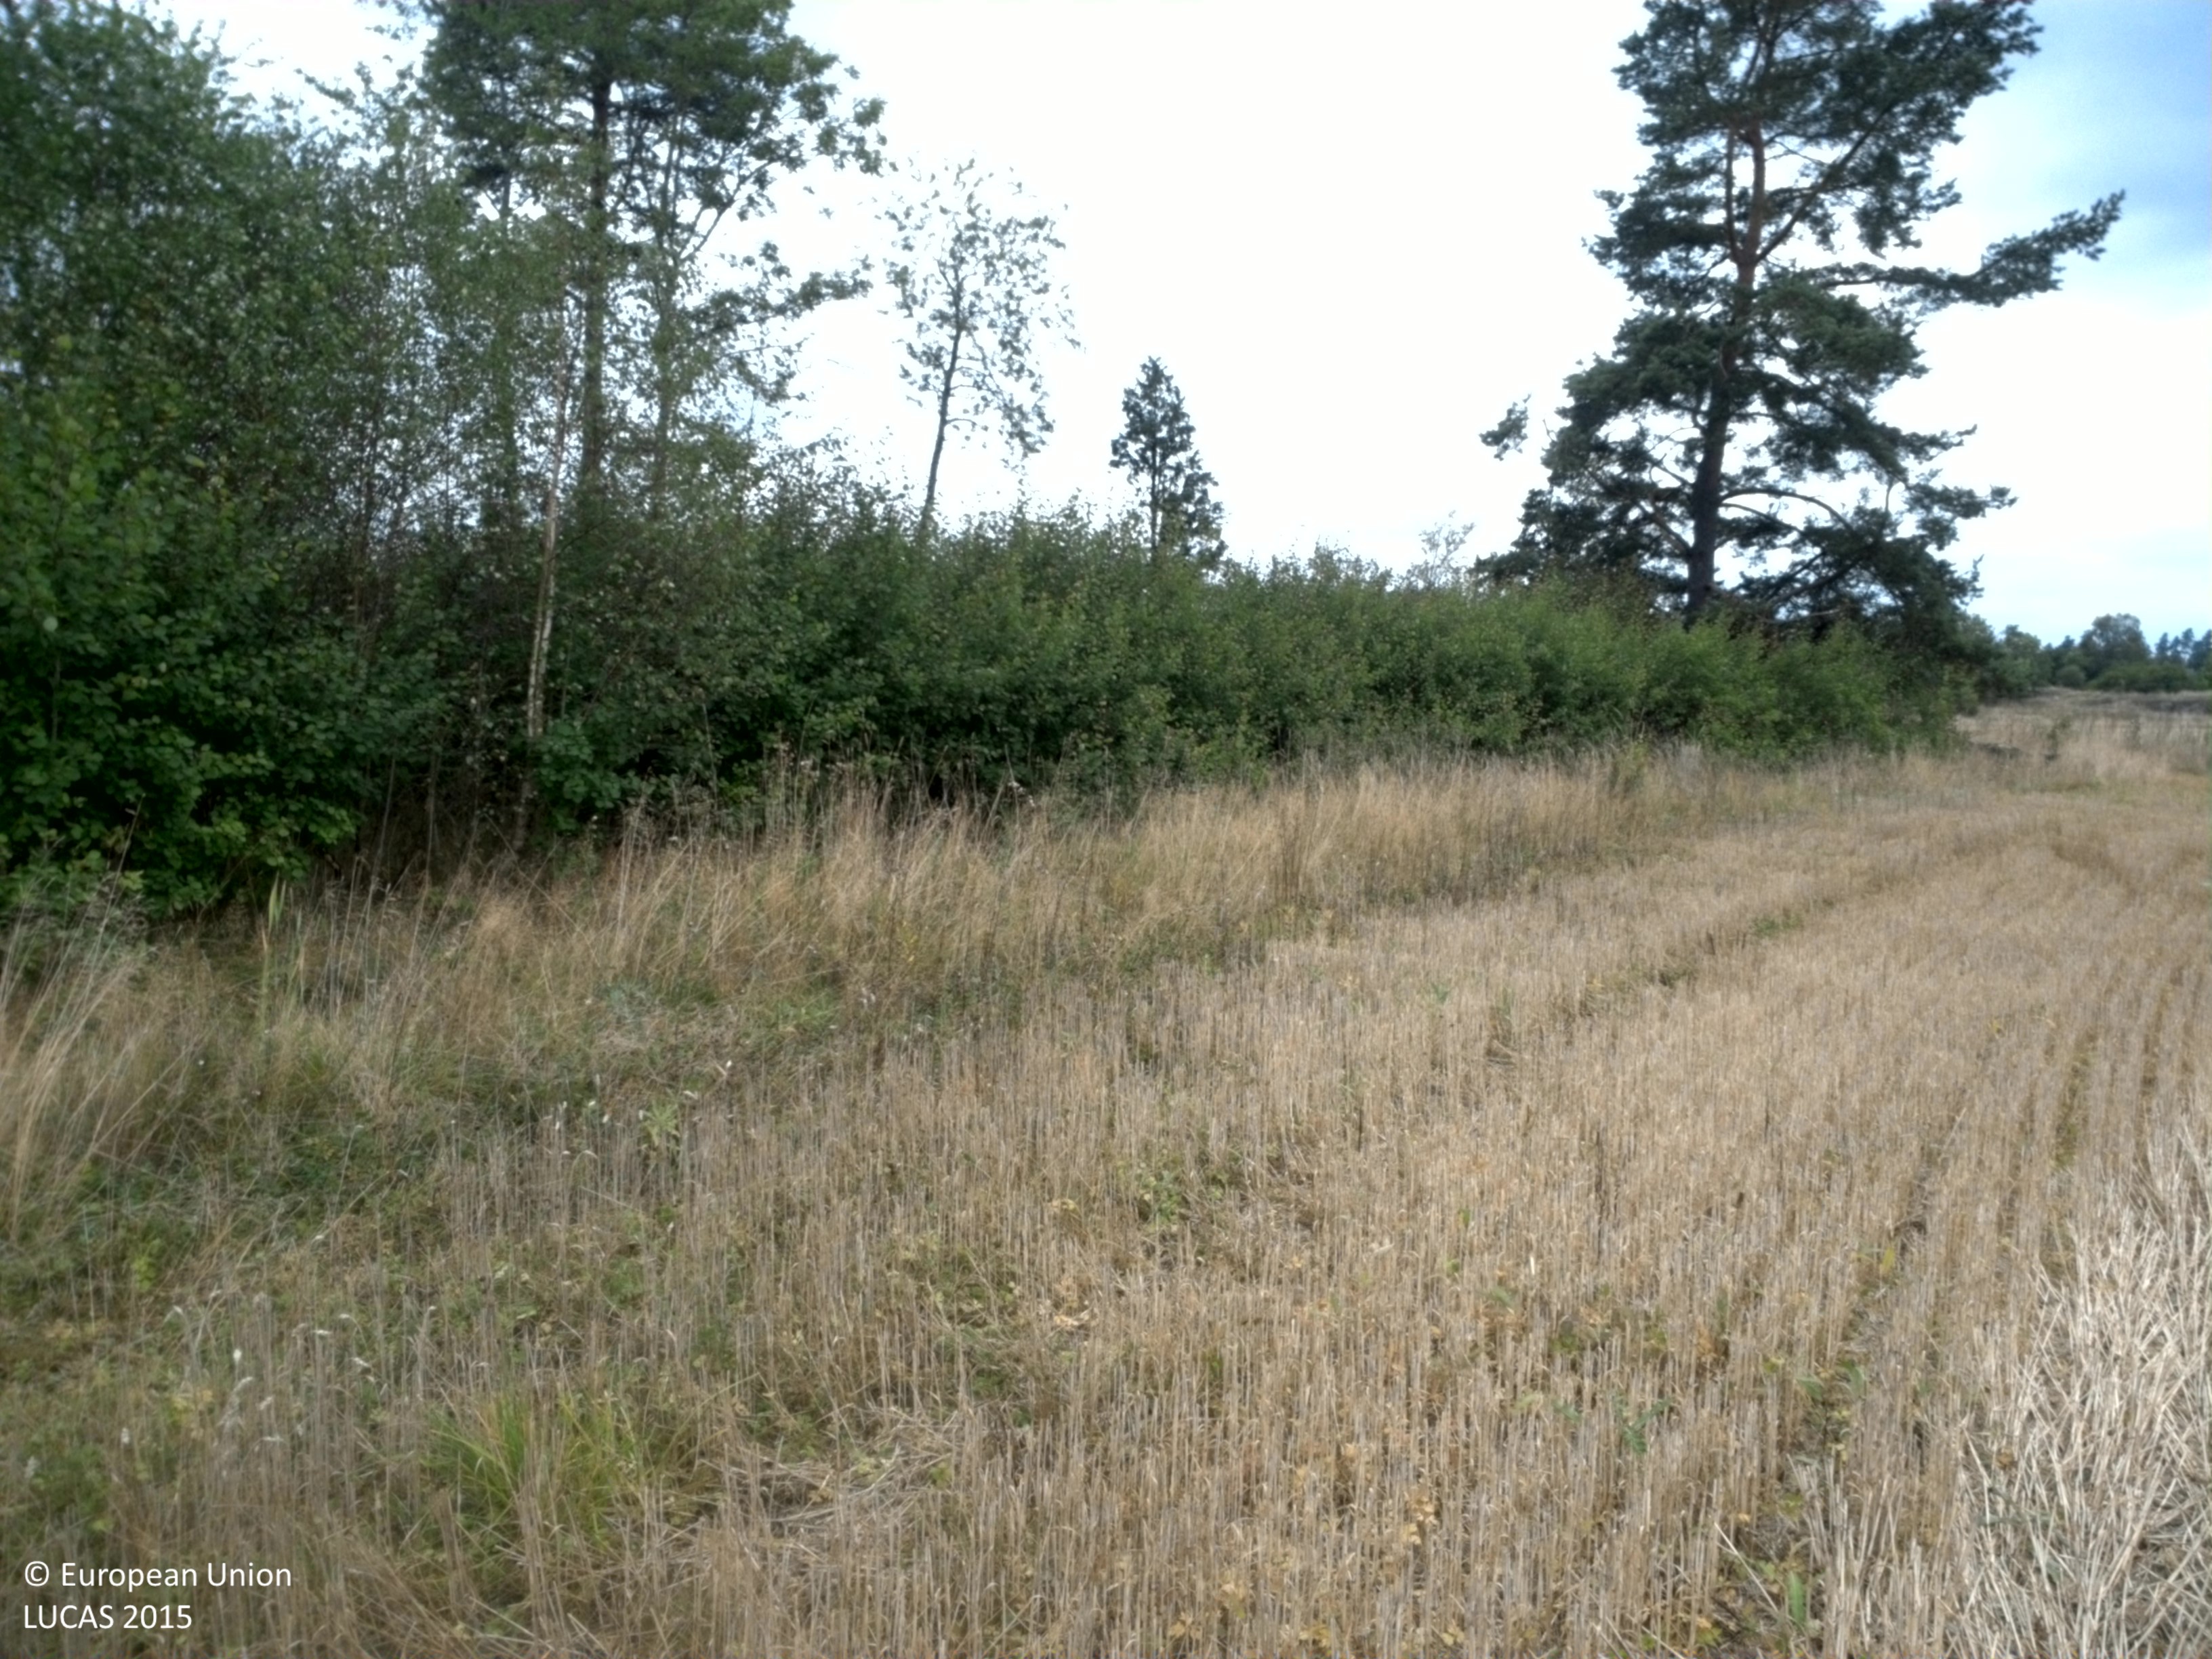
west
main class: Cropland
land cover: Common wheat
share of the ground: > 75 %
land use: Agriculture (excluding fallow land and kitchen gardens)
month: September
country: SE
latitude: 58.4038
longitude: 12.9208
